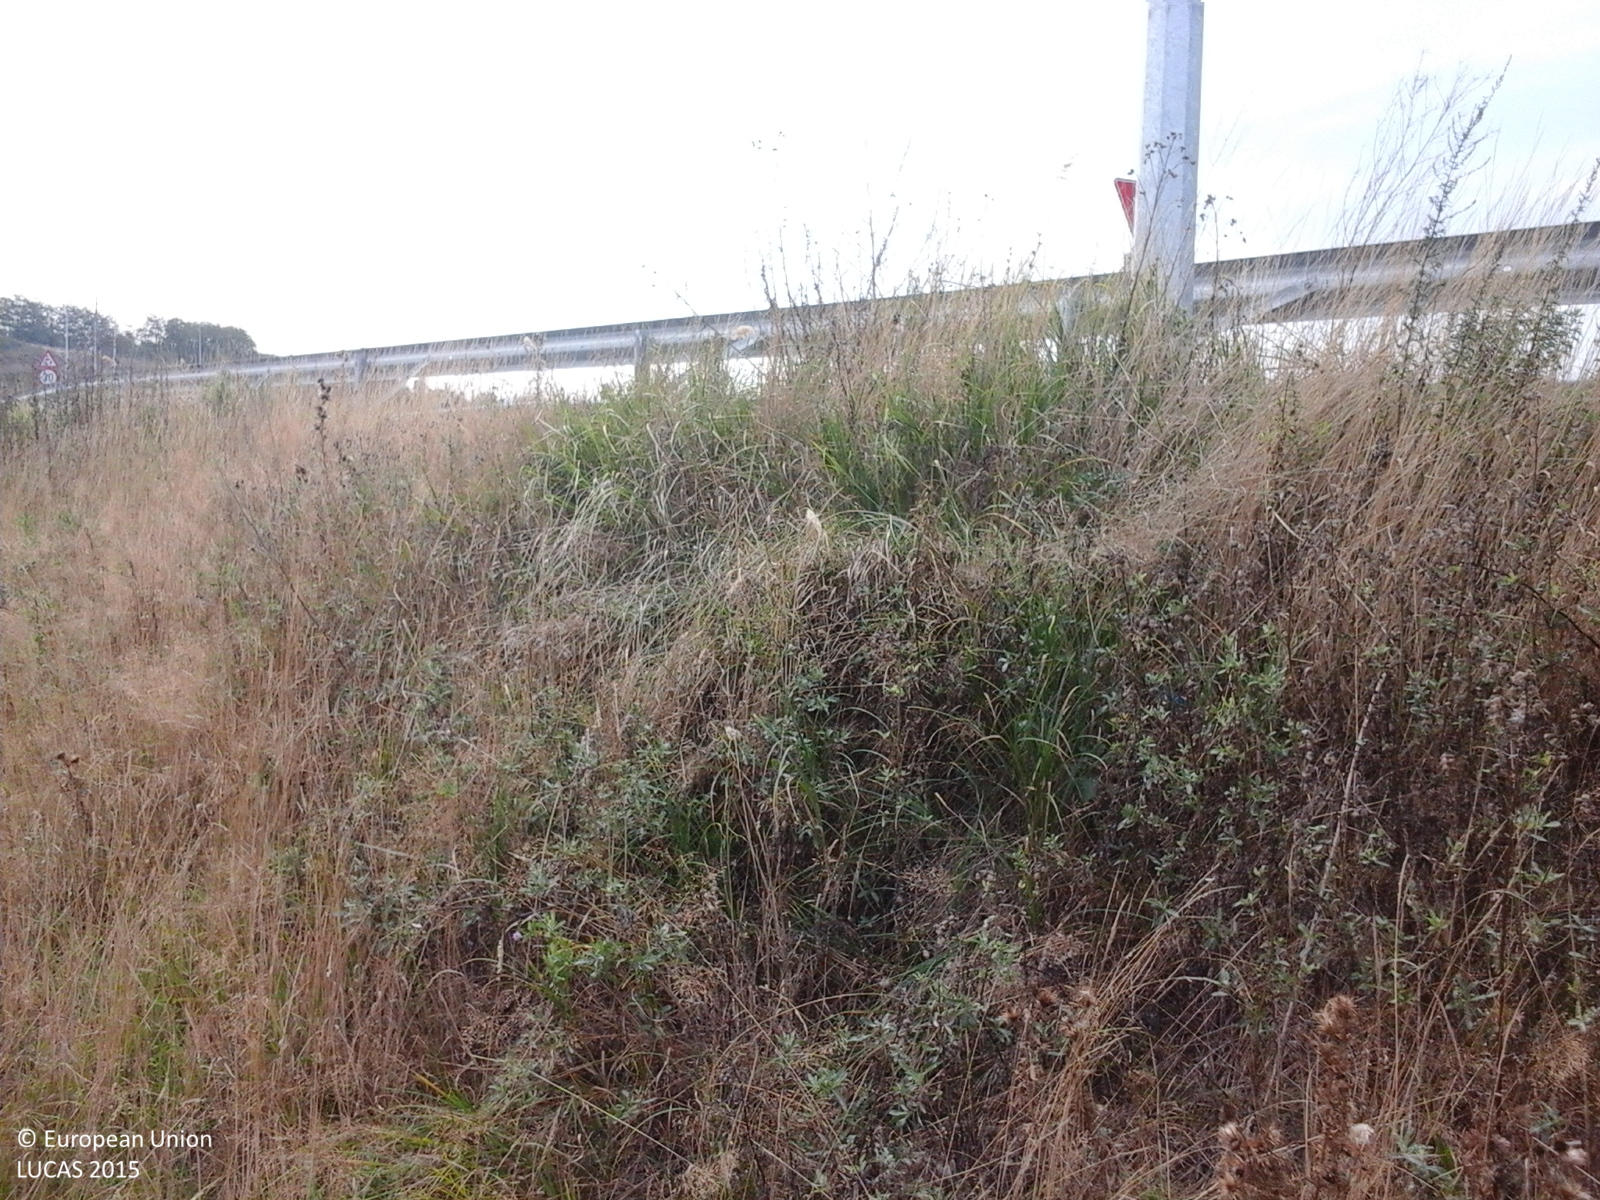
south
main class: Grassland
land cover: Spontaneously vegetated surfaces
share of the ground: > 75 %
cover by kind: herbaceous plants 100 %
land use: Protection infrastructures
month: September
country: RO
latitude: 45.4466
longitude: 22.2258
